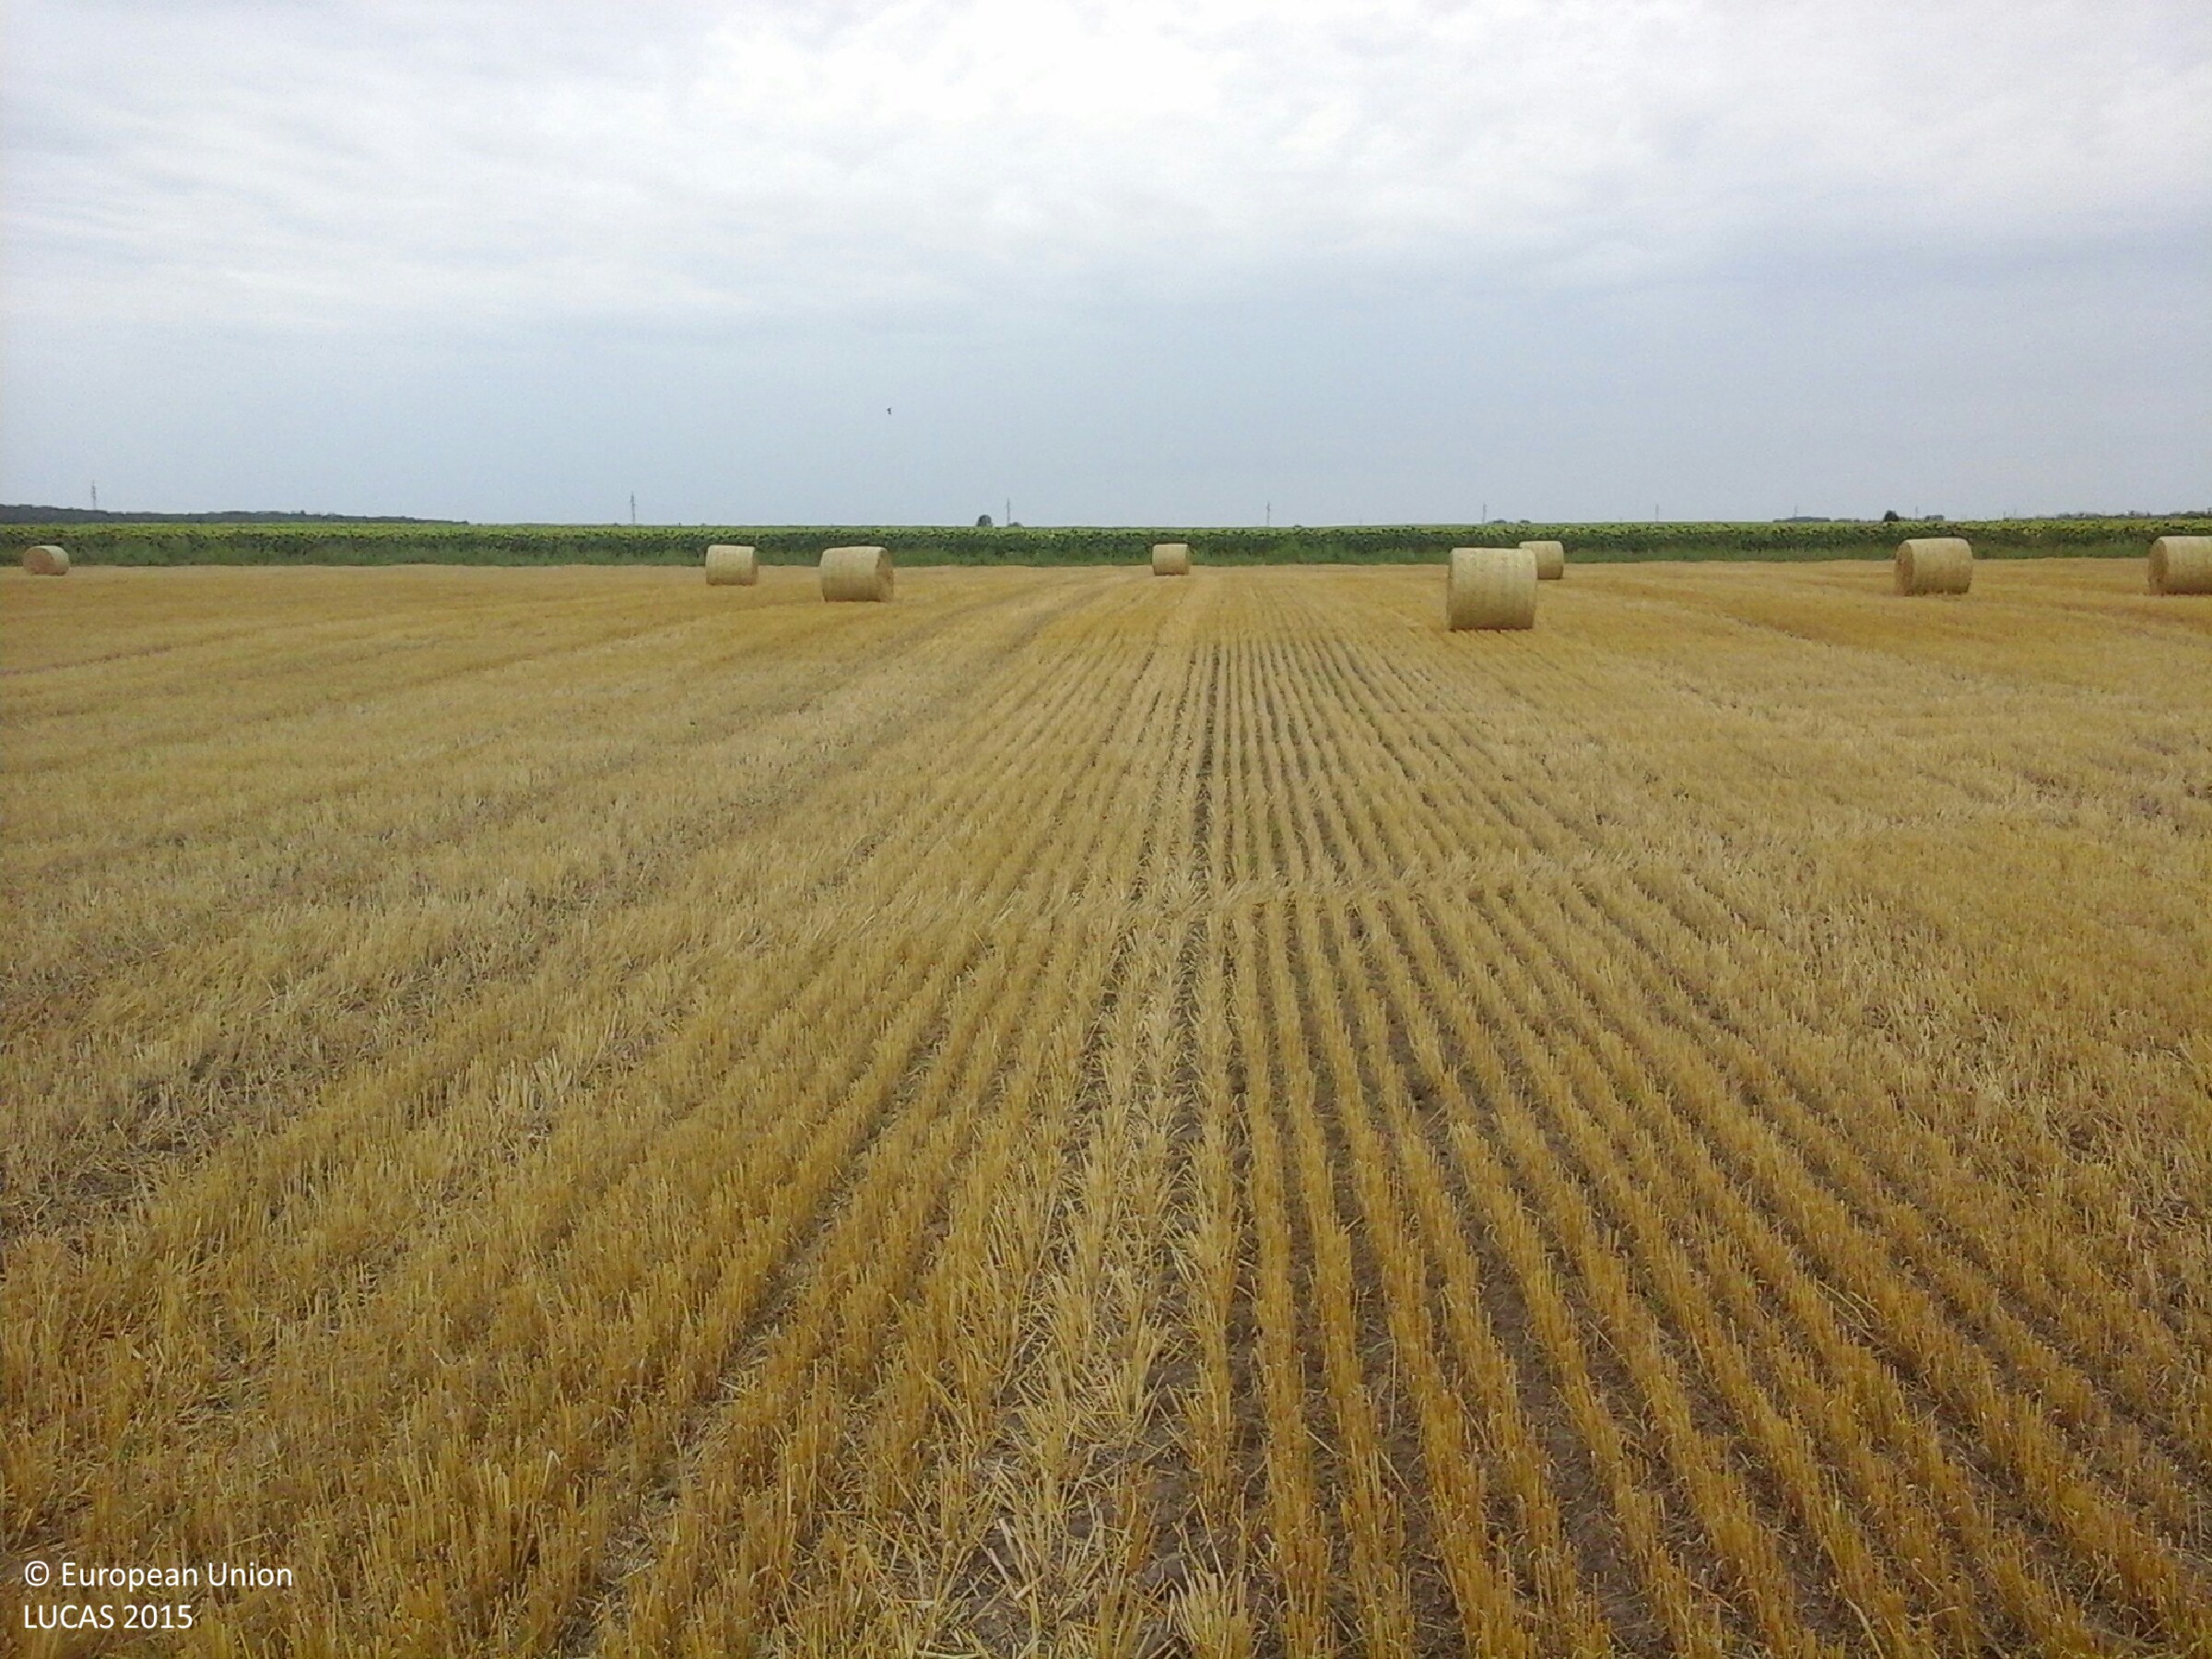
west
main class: Cropland
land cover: Common wheat
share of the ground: 25 - 50 %
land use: Agriculture (excluding fallow land and kitchen gardens)
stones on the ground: < 10 %
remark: Harvested field
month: July
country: HU
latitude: 47.4483
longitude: 20.8701
